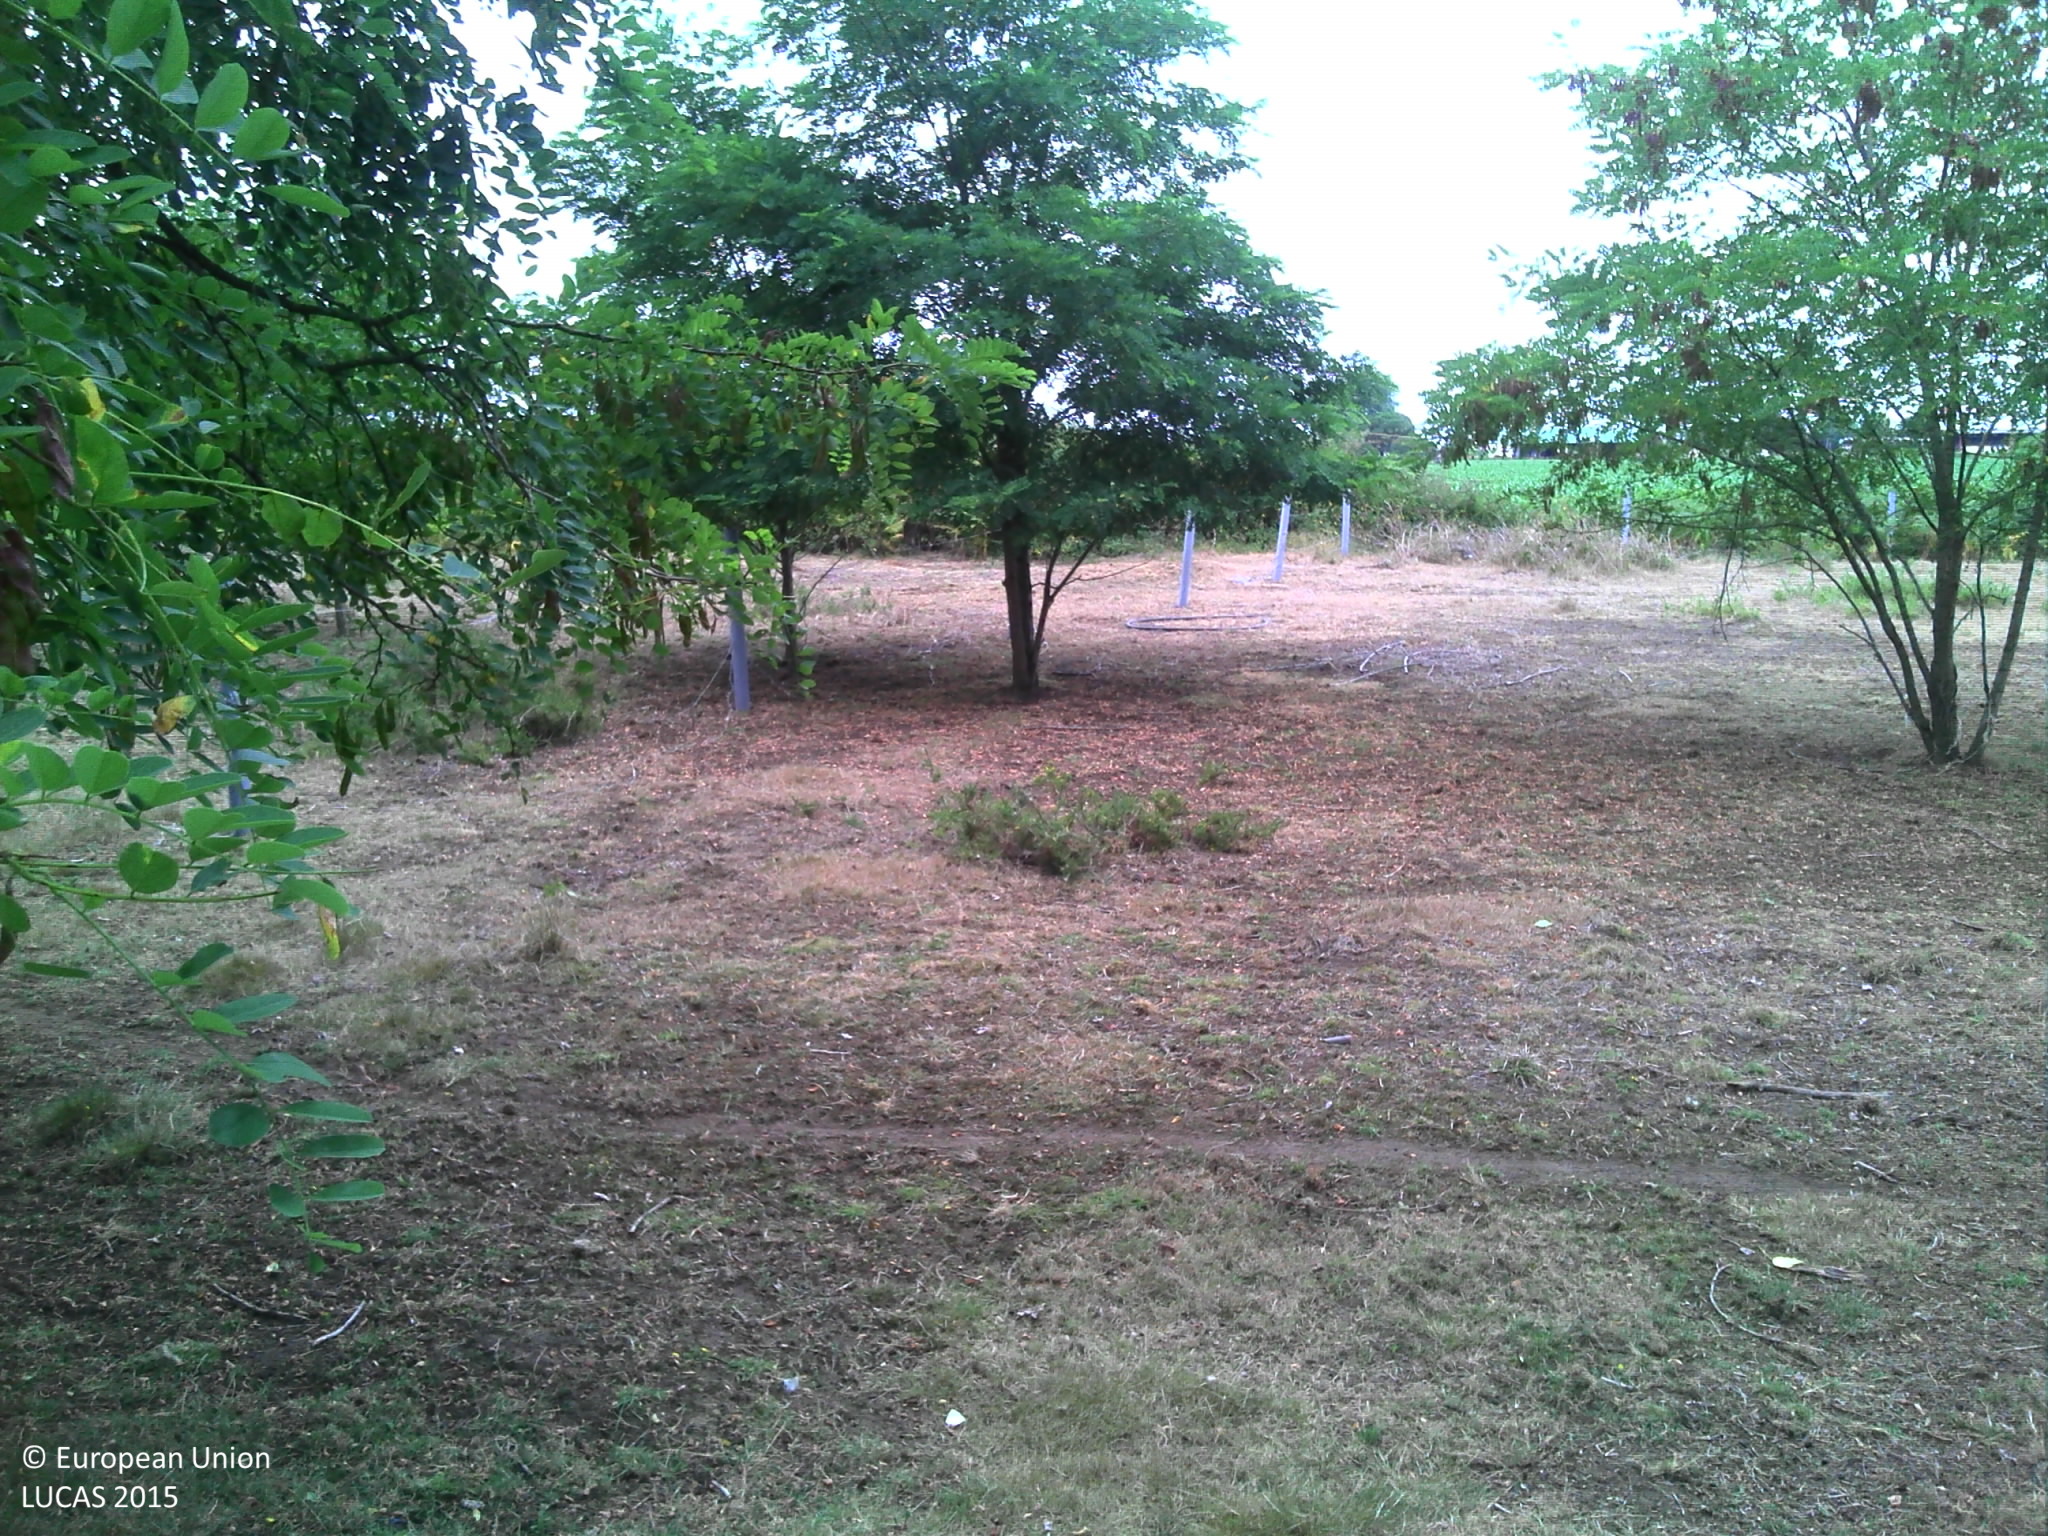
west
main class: Grassland
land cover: Grassland with sparse tree/shrub cover
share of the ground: > 75 %
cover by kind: herbaceous plants 95 %, broadleaved forest trees 5 %
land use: Residential
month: July
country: FR
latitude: 44.0896
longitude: -0.8449
